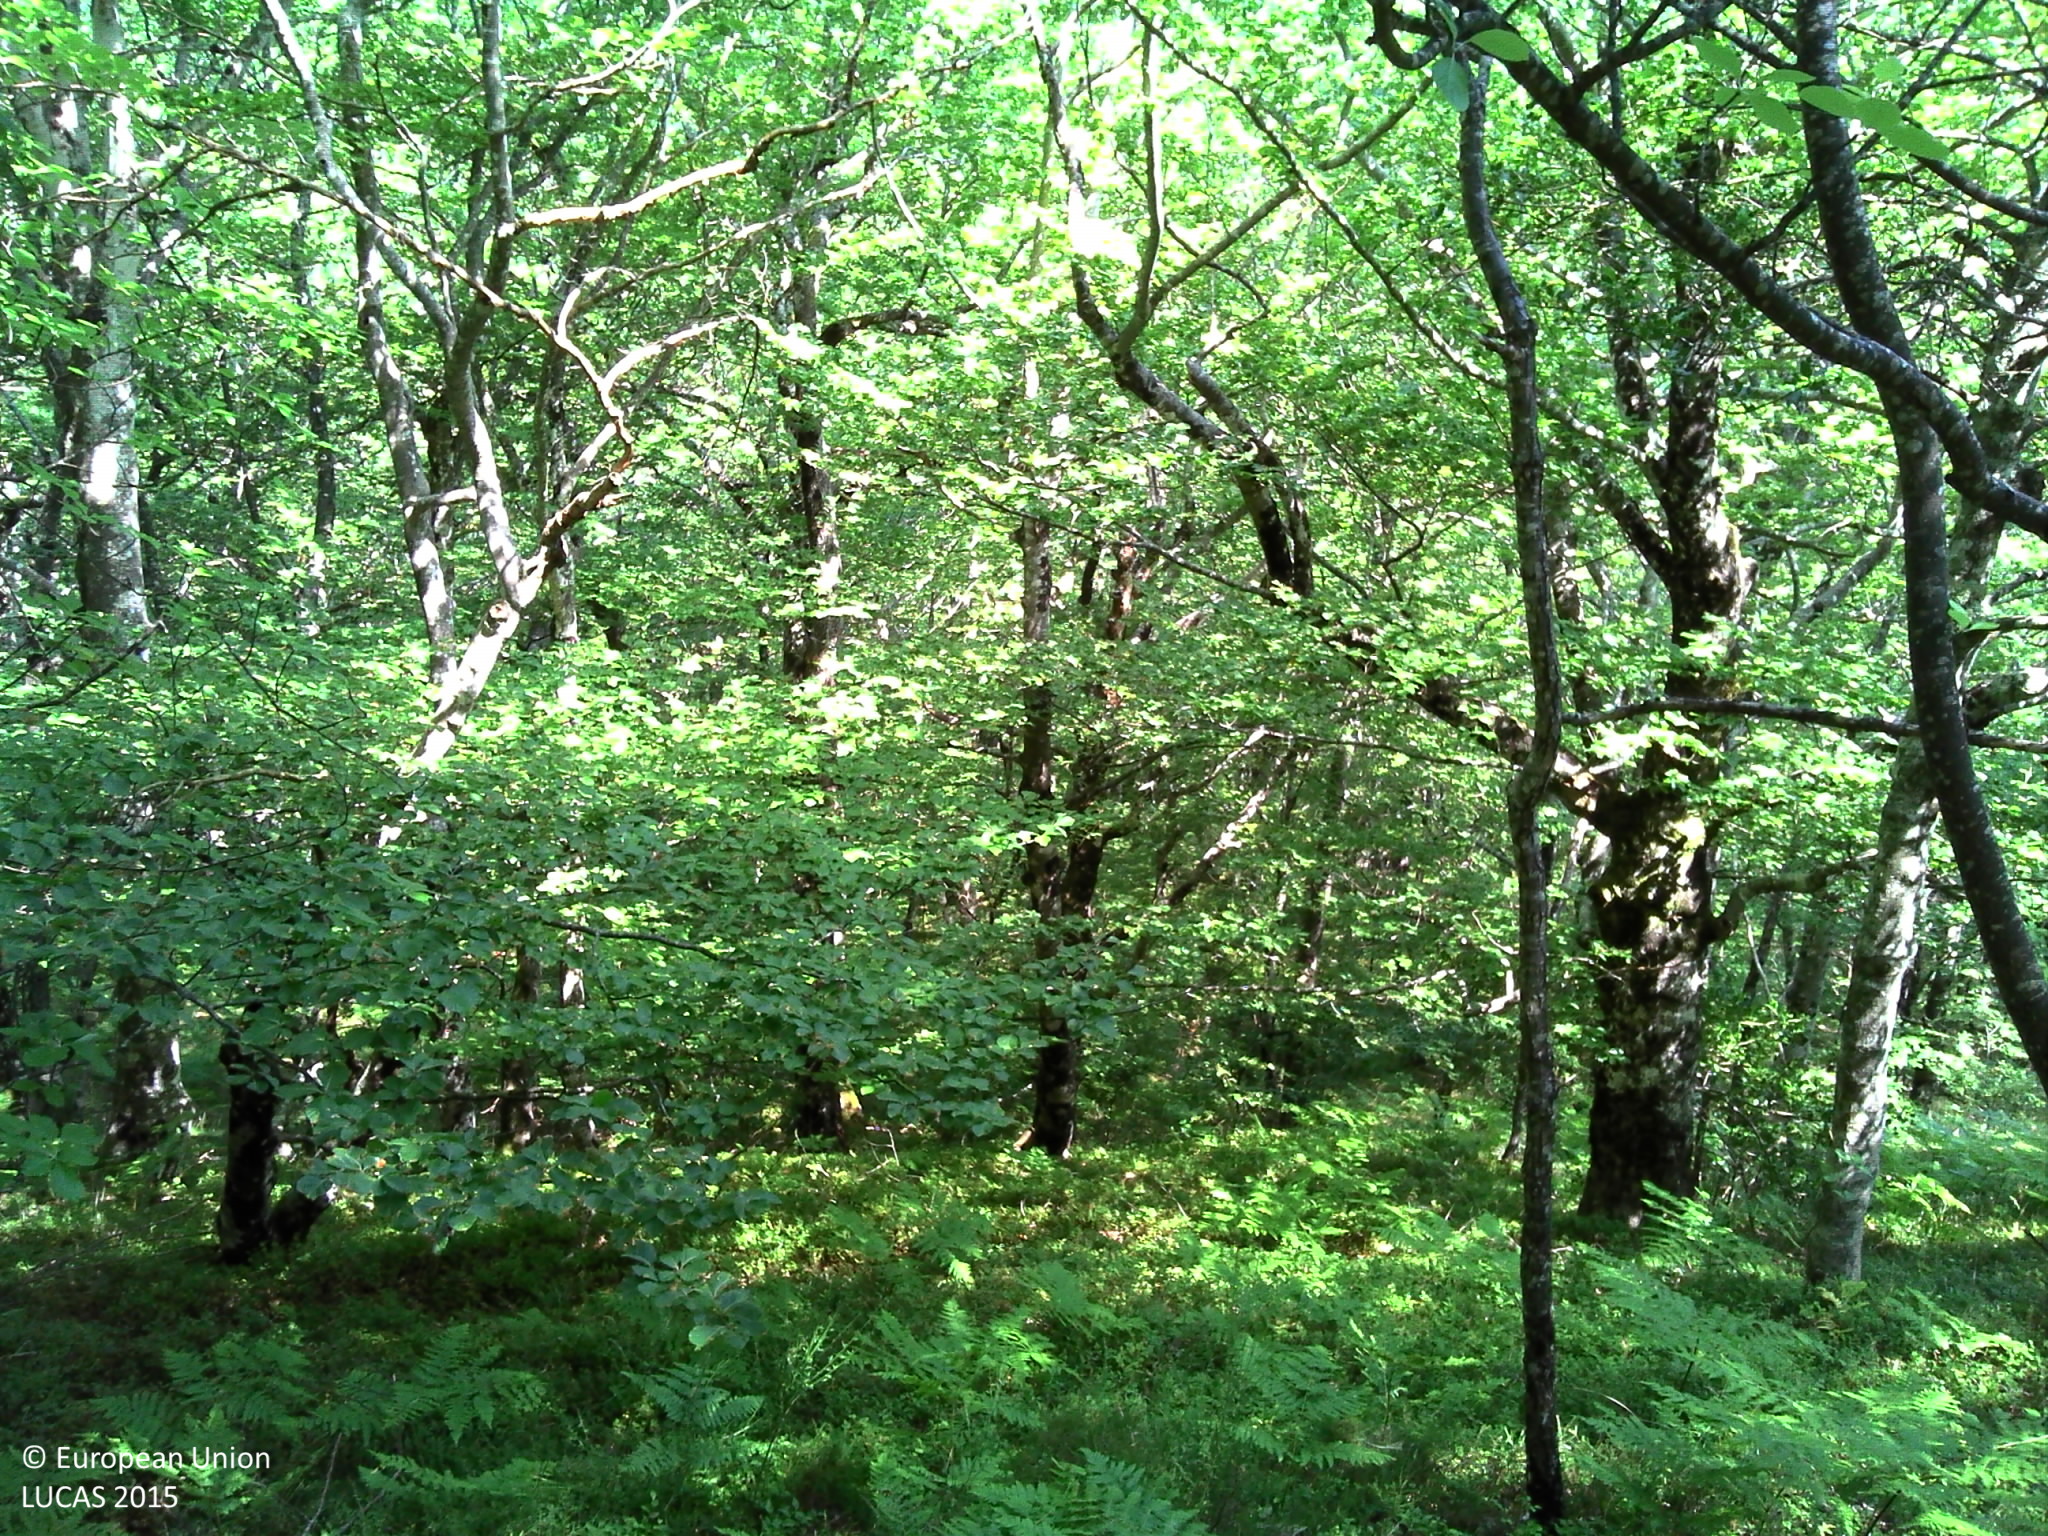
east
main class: Woodland
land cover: Broadleaved woodland
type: acidophilous oak and oak-birch forest
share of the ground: > 75 %
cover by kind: broadleaved forest trees 90 %, shrubs 5 %, herbaceous plants 5 %
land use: Semi-natural and natural areas not in use
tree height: > 5 m
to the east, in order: Broadleaved woodland; Rivers and streams; Broadleaved woodland; Tracks; Broadleaved woodland
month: July
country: FR
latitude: 44.5299
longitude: 2.9950
